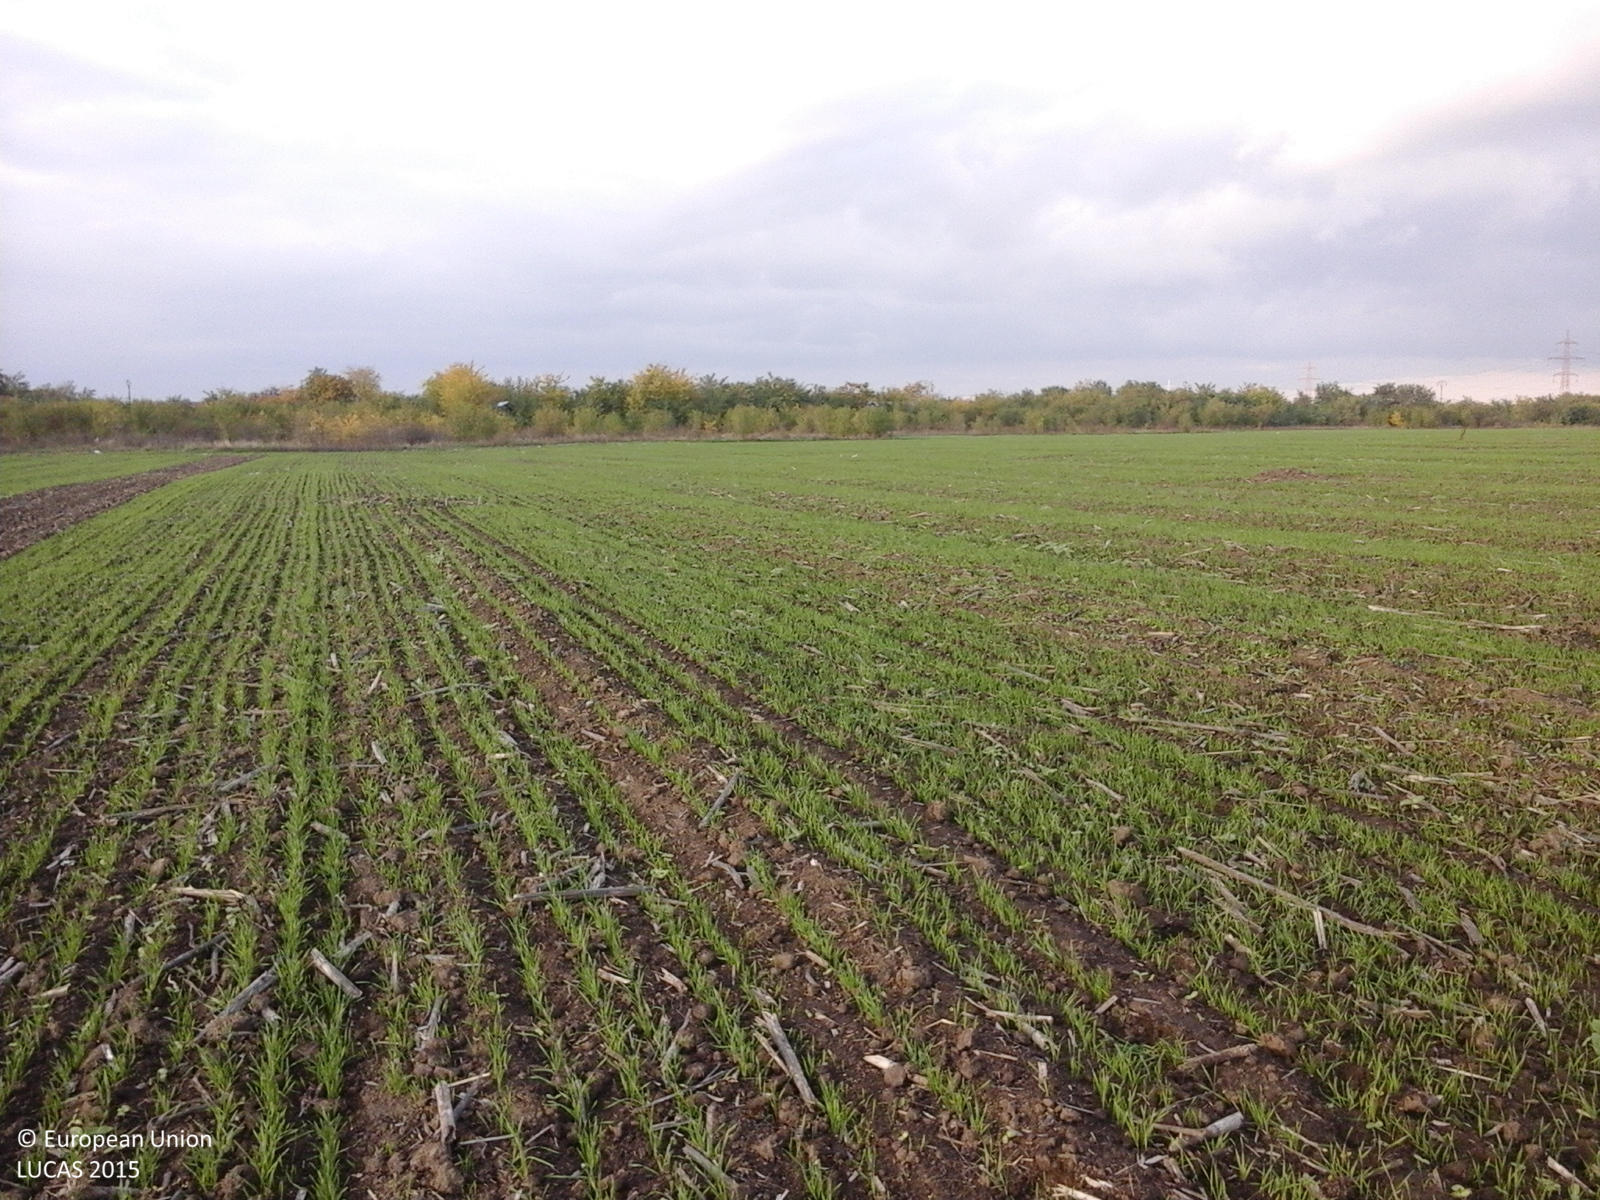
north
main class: Cropland
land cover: Common wheat
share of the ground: 25 - 50 %
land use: Agriculture (excluding fallow land and kitchen gardens)
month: October
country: RO
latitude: 44.6837
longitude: 25.9634
